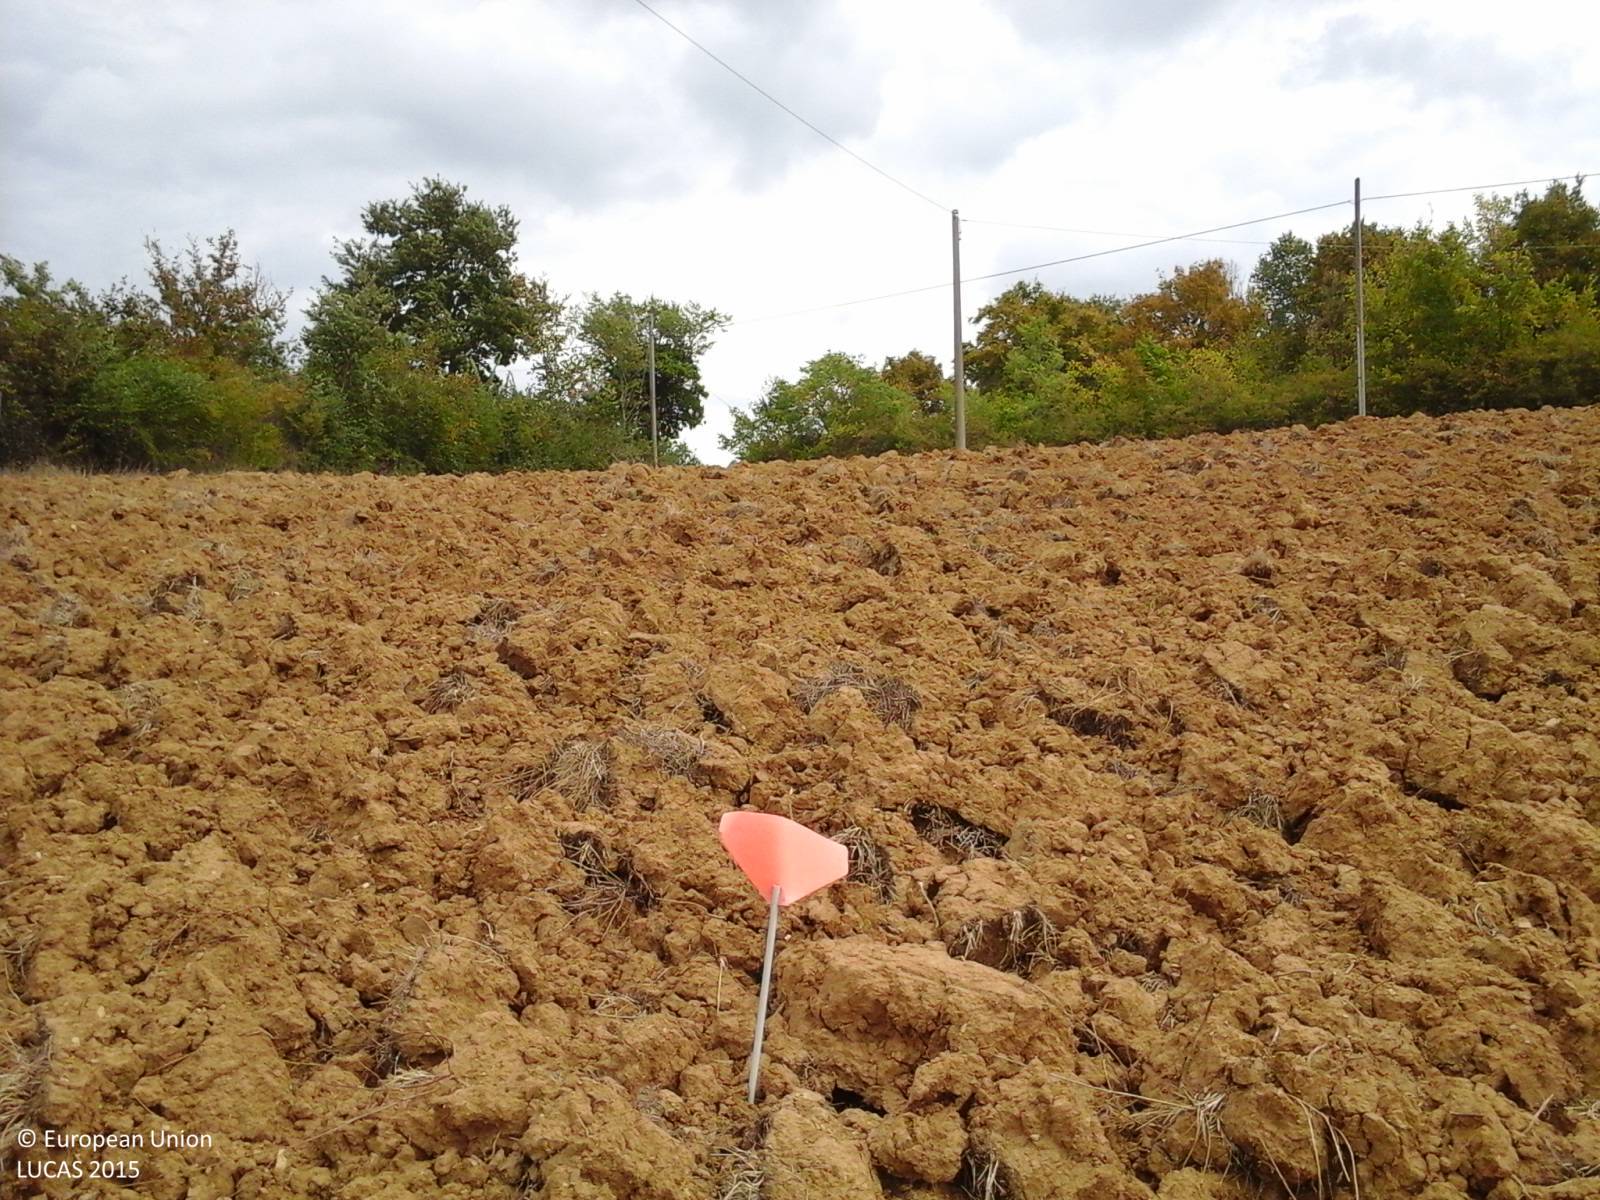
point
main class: Cropland
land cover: Lucerne
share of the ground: < 10 %
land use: Agriculture (excluding fallow land and kitchen gardens)
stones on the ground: 10 - 25 %
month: September
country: IT
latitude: 42.8834
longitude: 12.1849
